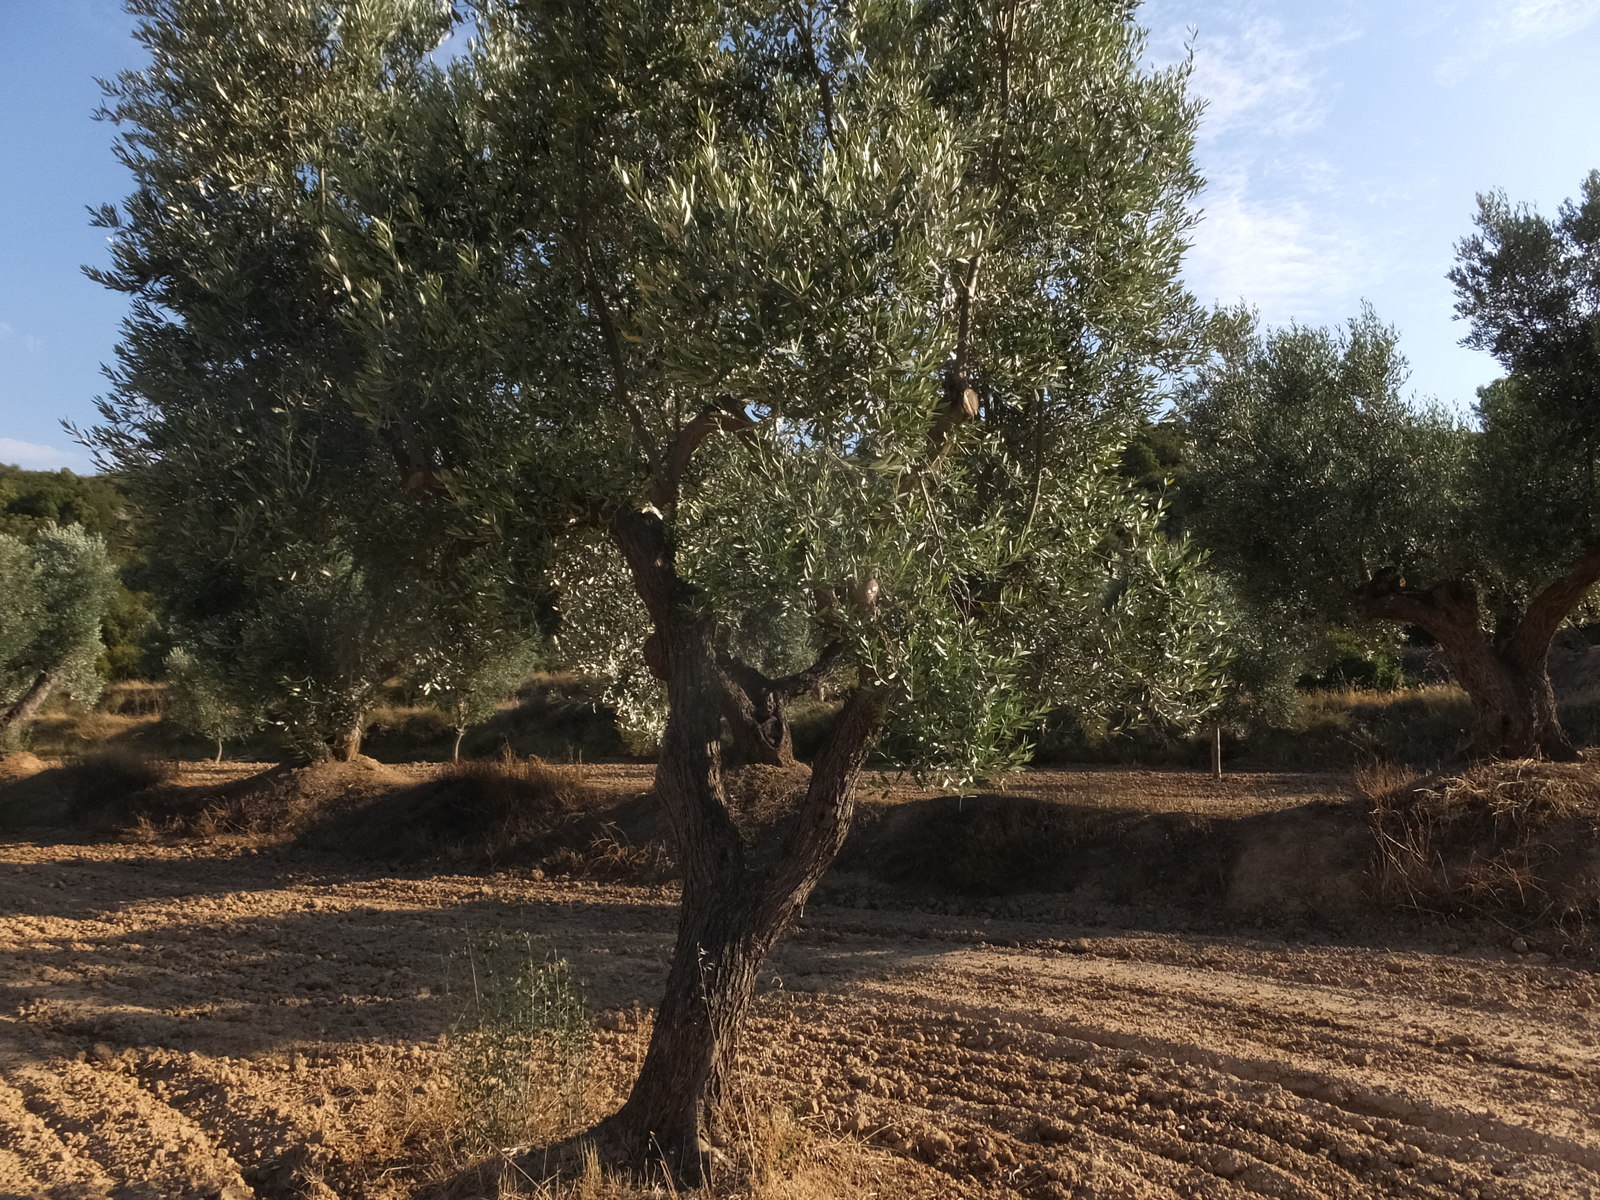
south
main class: Cropland
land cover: Olive groves
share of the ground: 50 - 75 %
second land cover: Other bare soil
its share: > 75 %
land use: Agriculture (excluding fallow land and kitchen gardens)
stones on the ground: < 10 %
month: July
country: ES
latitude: 41.0990
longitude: 0.1431
